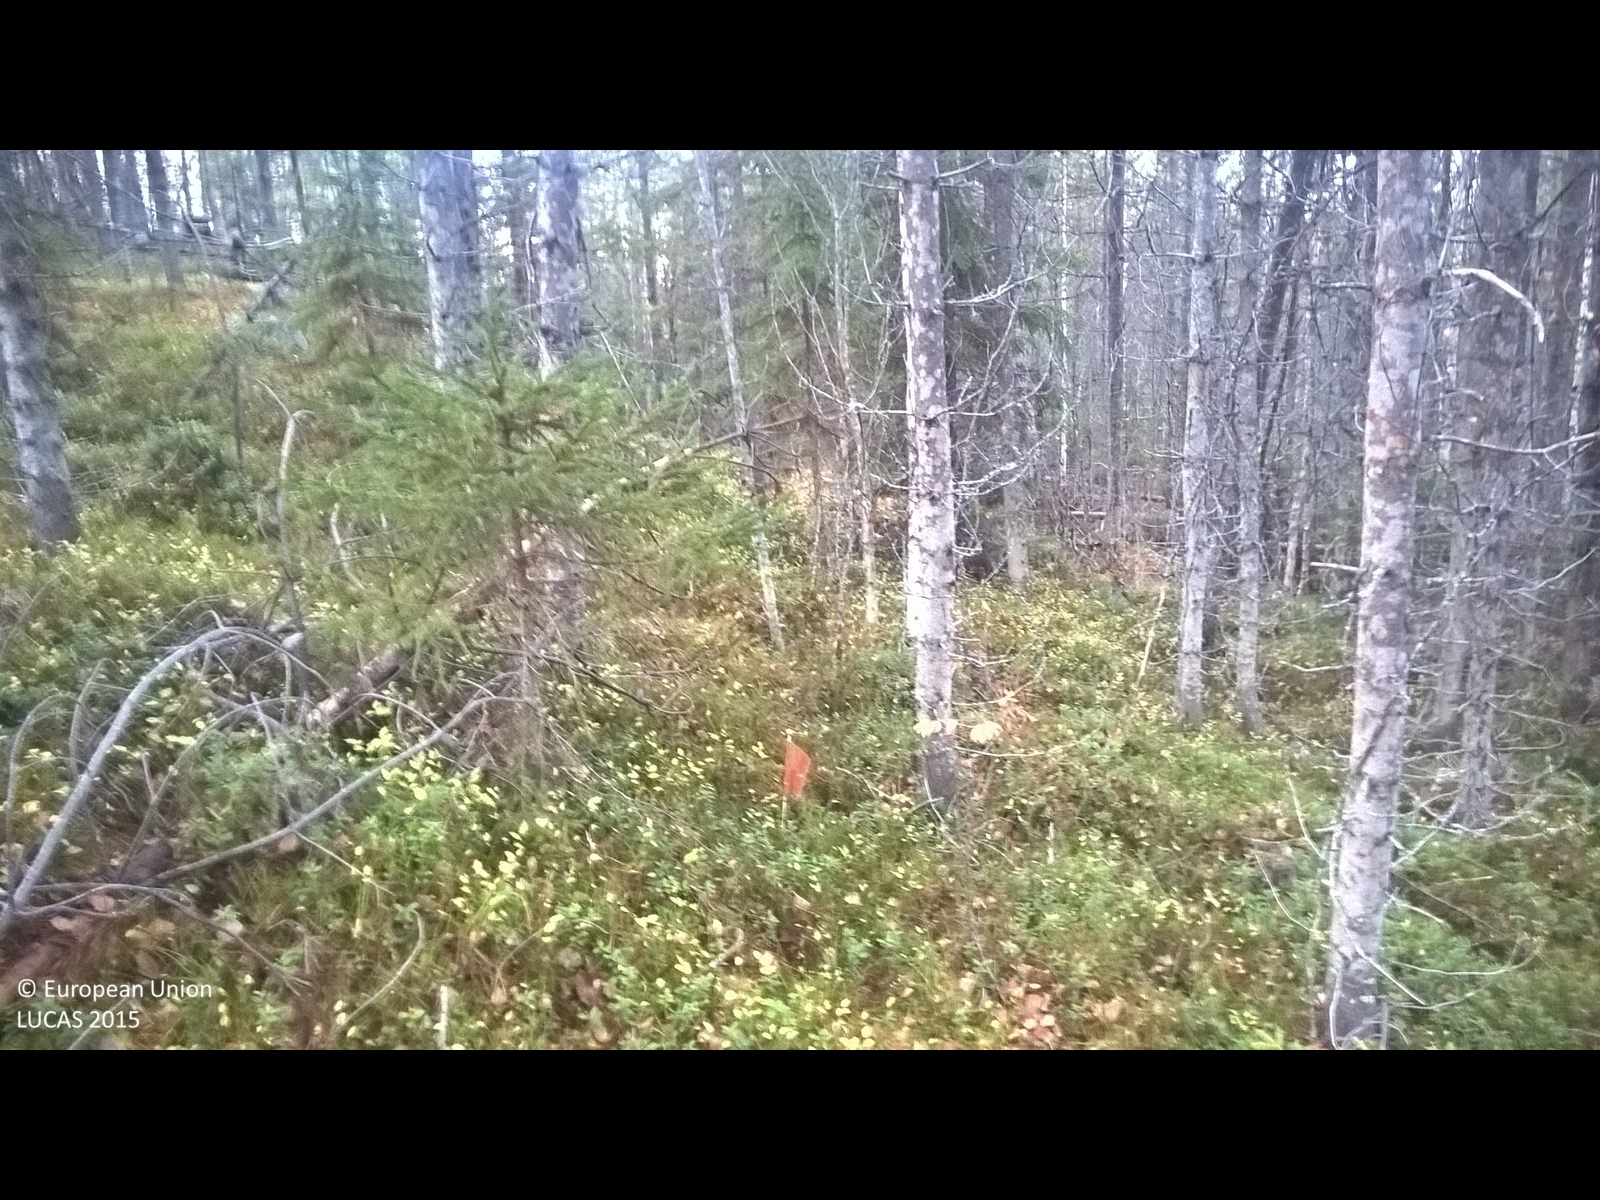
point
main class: Woodland
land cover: Pine dominated coniferous woodland
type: exotic forest
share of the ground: > 75 %
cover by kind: coniferous forest trees 75 %, lichens and mosses 25 %
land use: Forestry
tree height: > 5 m
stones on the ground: < 10 %
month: October
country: SE
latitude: 63.0614
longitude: 15.2998
